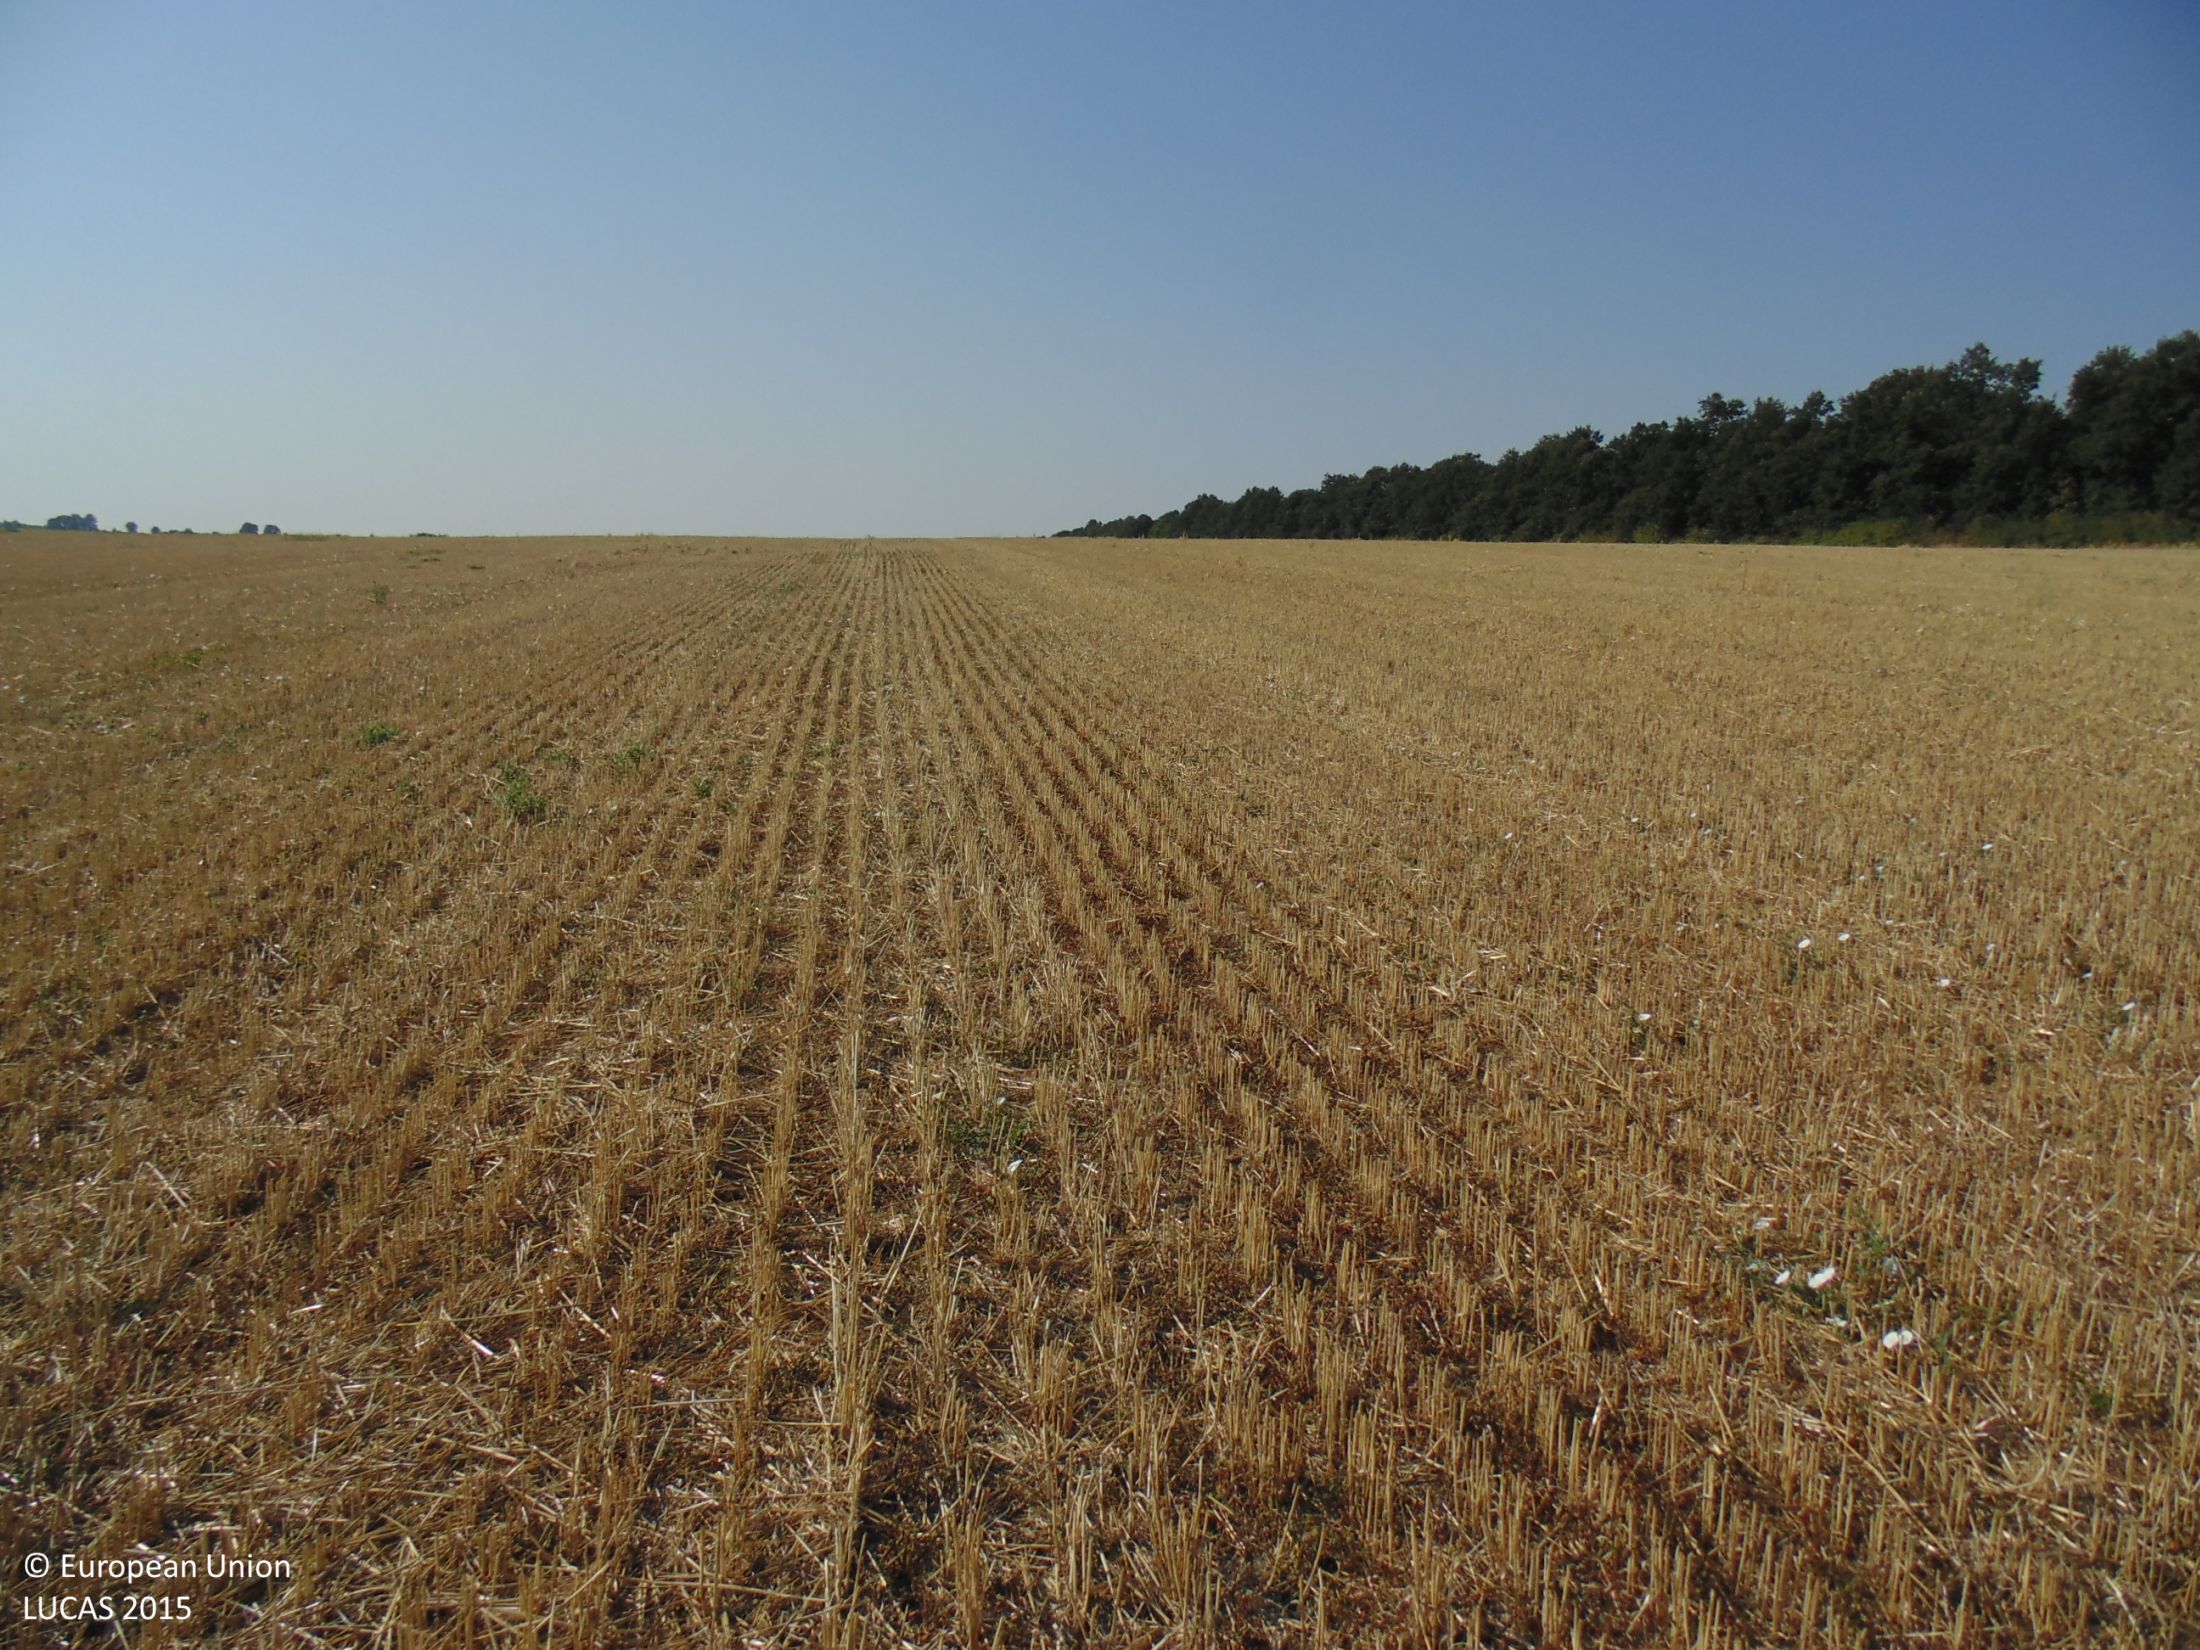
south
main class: Cropland
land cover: Common wheat
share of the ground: 50 - 75 %
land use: Agriculture (excluding fallow land and kitchen gardens)
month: August
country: BG
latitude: 44.0029
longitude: 27.4332
